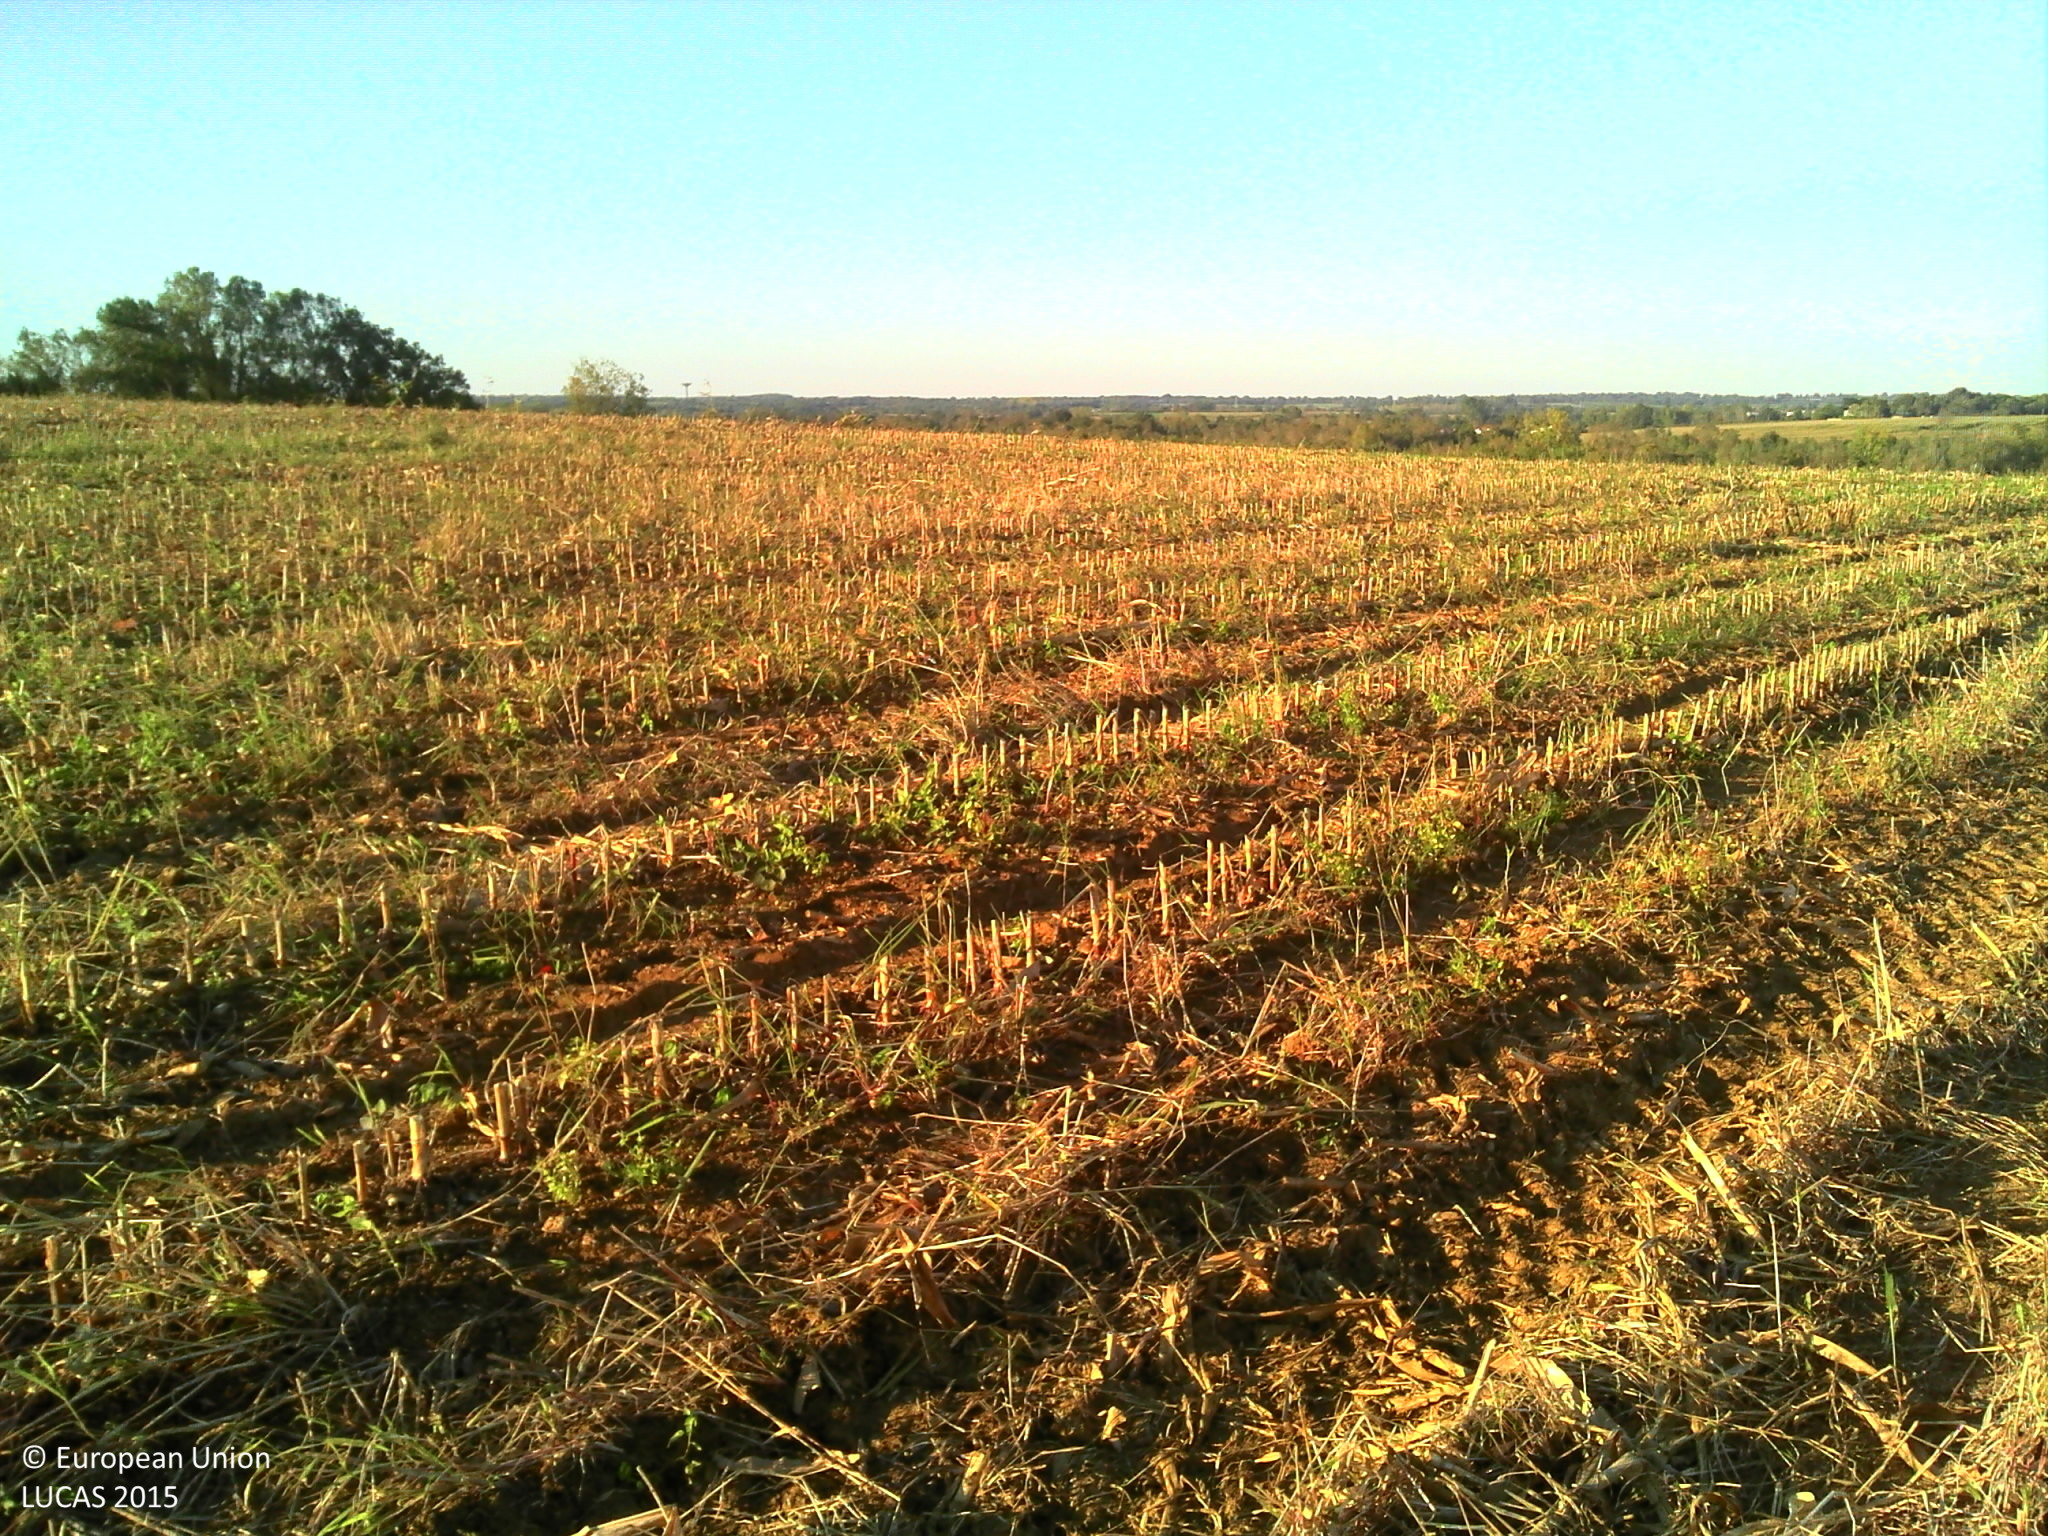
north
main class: Cropland
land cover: Maize
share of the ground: 10 - 25 %
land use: Agriculture (excluding fallow land and kitchen gardens)
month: September
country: FR
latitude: 46.4978
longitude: -1.2798
